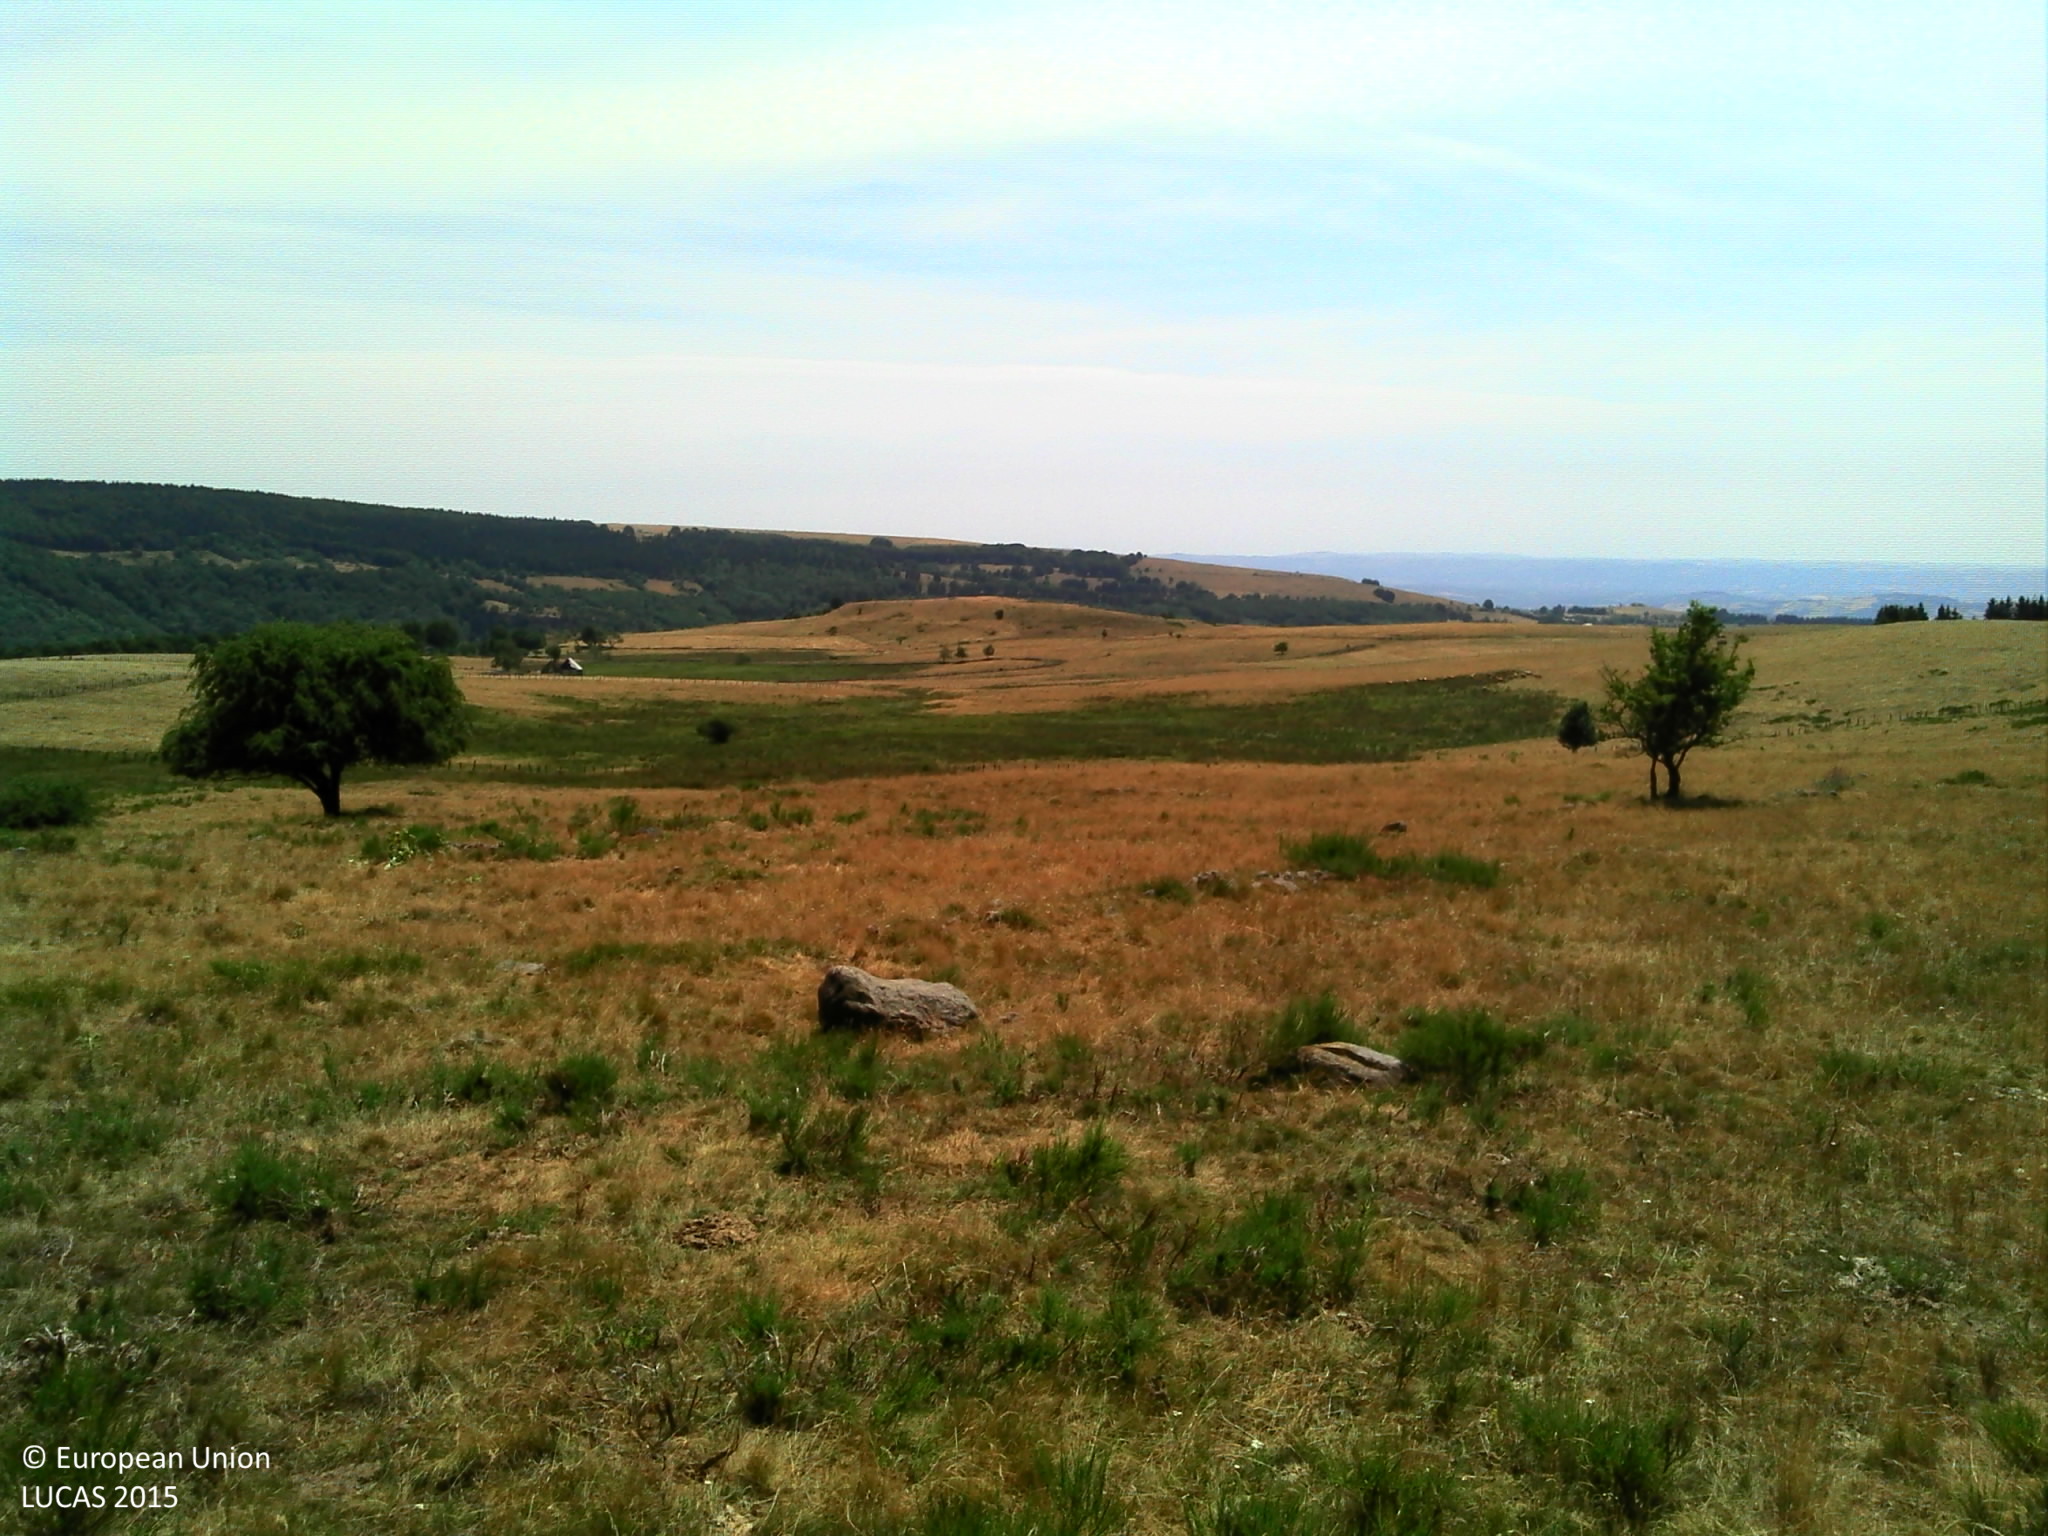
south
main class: Grassland
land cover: Grassland without tree/shrub cover
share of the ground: > 75 %
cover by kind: herbaceous plants 90 %, shrubs 5 %, consolidated bare surface 5 %
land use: Agriculture (excluding fallow land and kitchen gardens)
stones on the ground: > 50 %
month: July
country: FR
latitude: 44.6179
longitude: 2.9587
